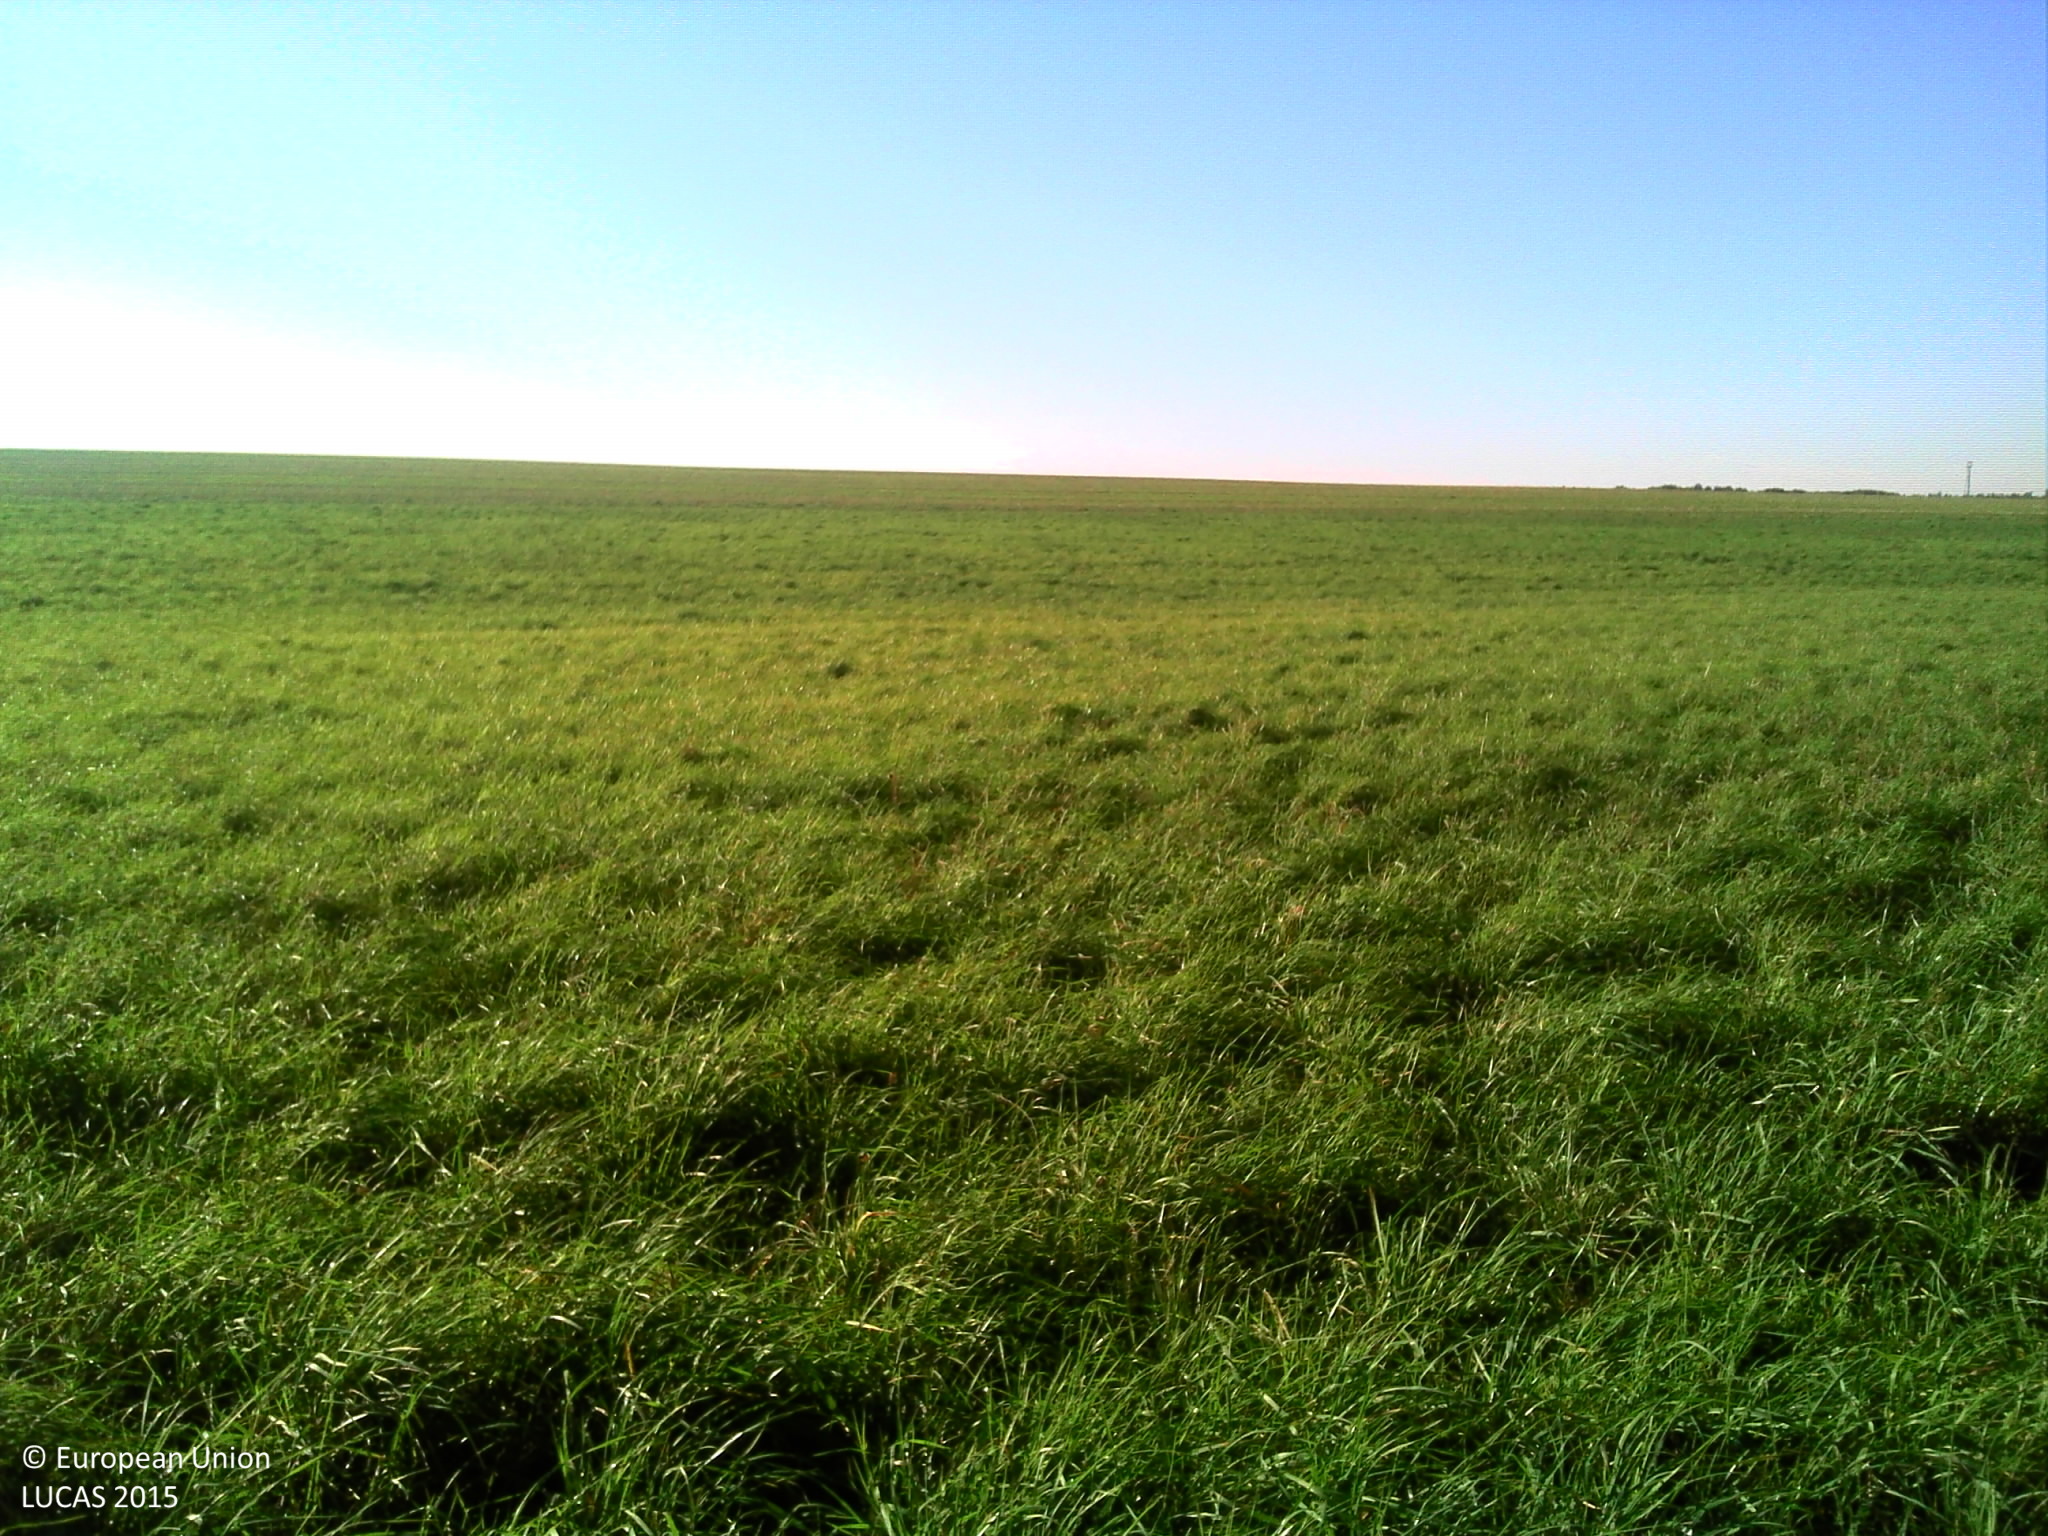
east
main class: Cropland
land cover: Temporary grasslands
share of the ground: > 75 %
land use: Agriculture (excluding fallow land and kitchen gardens)
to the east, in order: Temporary grasslands; Common wheat; Grass margins; Tracks; Grass margins; Common wheat
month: October
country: FR
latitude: 49.1411
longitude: 5.9831
